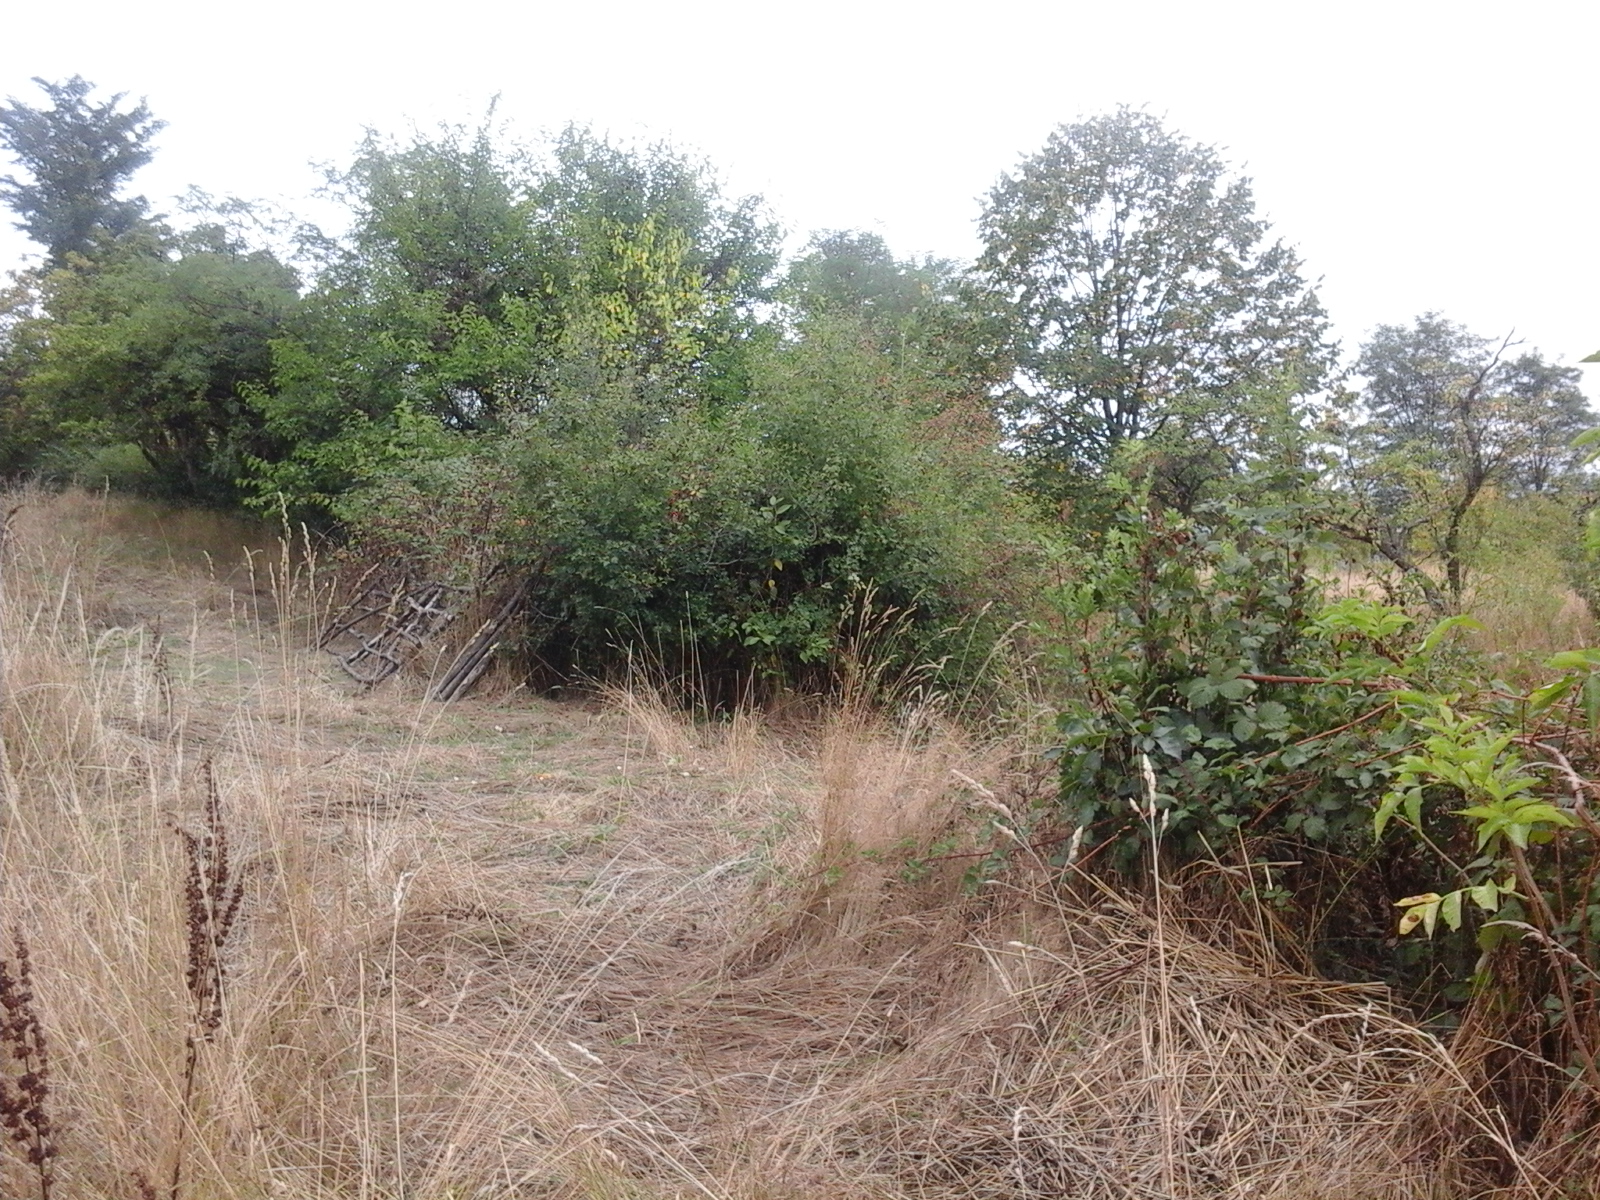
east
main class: Cropland
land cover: Common wheat
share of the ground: > 75 %
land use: Agriculture (excluding fallow land and kitchen gardens)
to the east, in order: Common wheat; Shrubland with sparse tree cover; Other fruit trees and berries; Tracks; Other fruit trees and berries; Tracks; Broadleaved woodland
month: August
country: RO
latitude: 45.2151
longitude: 21.8645
